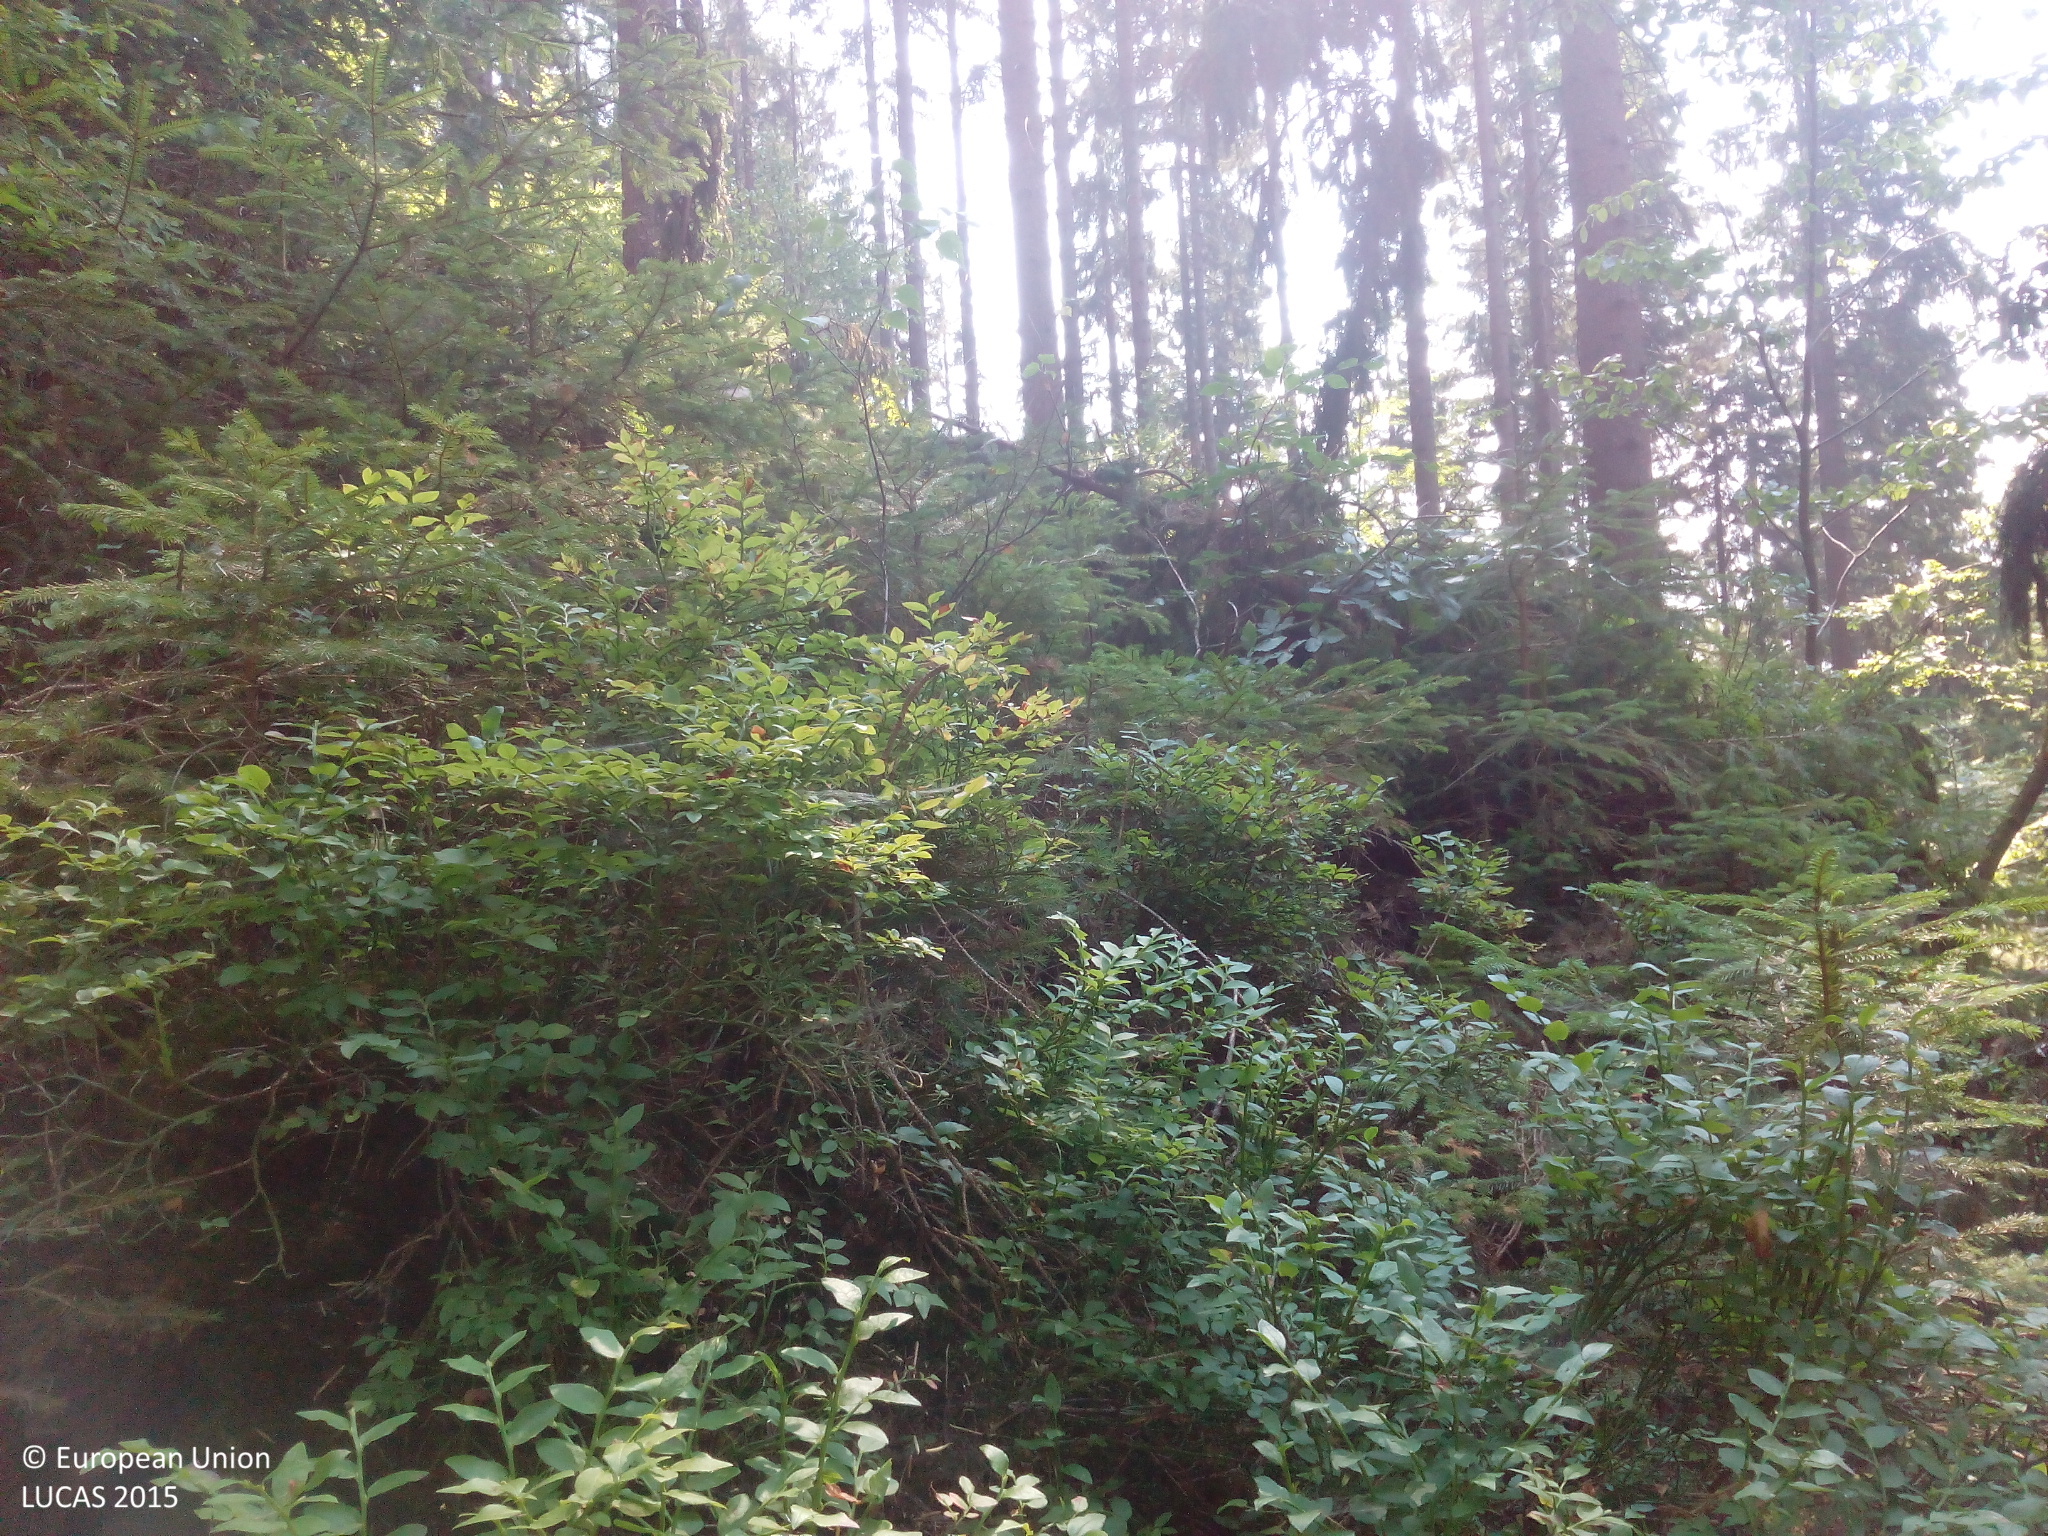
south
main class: Woodland
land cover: Spruce dominated coniferous woodland
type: hemiboreal forest and nemoral coniferous forest and mixed broadleaved-coniferous forest
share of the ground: > 75 %
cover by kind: coniferous forest trees 90 %, shrubs 10 %
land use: Forestry
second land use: Amenities, museums, leisure
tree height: > 5 m
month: August
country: DE
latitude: 50.2991
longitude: 11.5860
